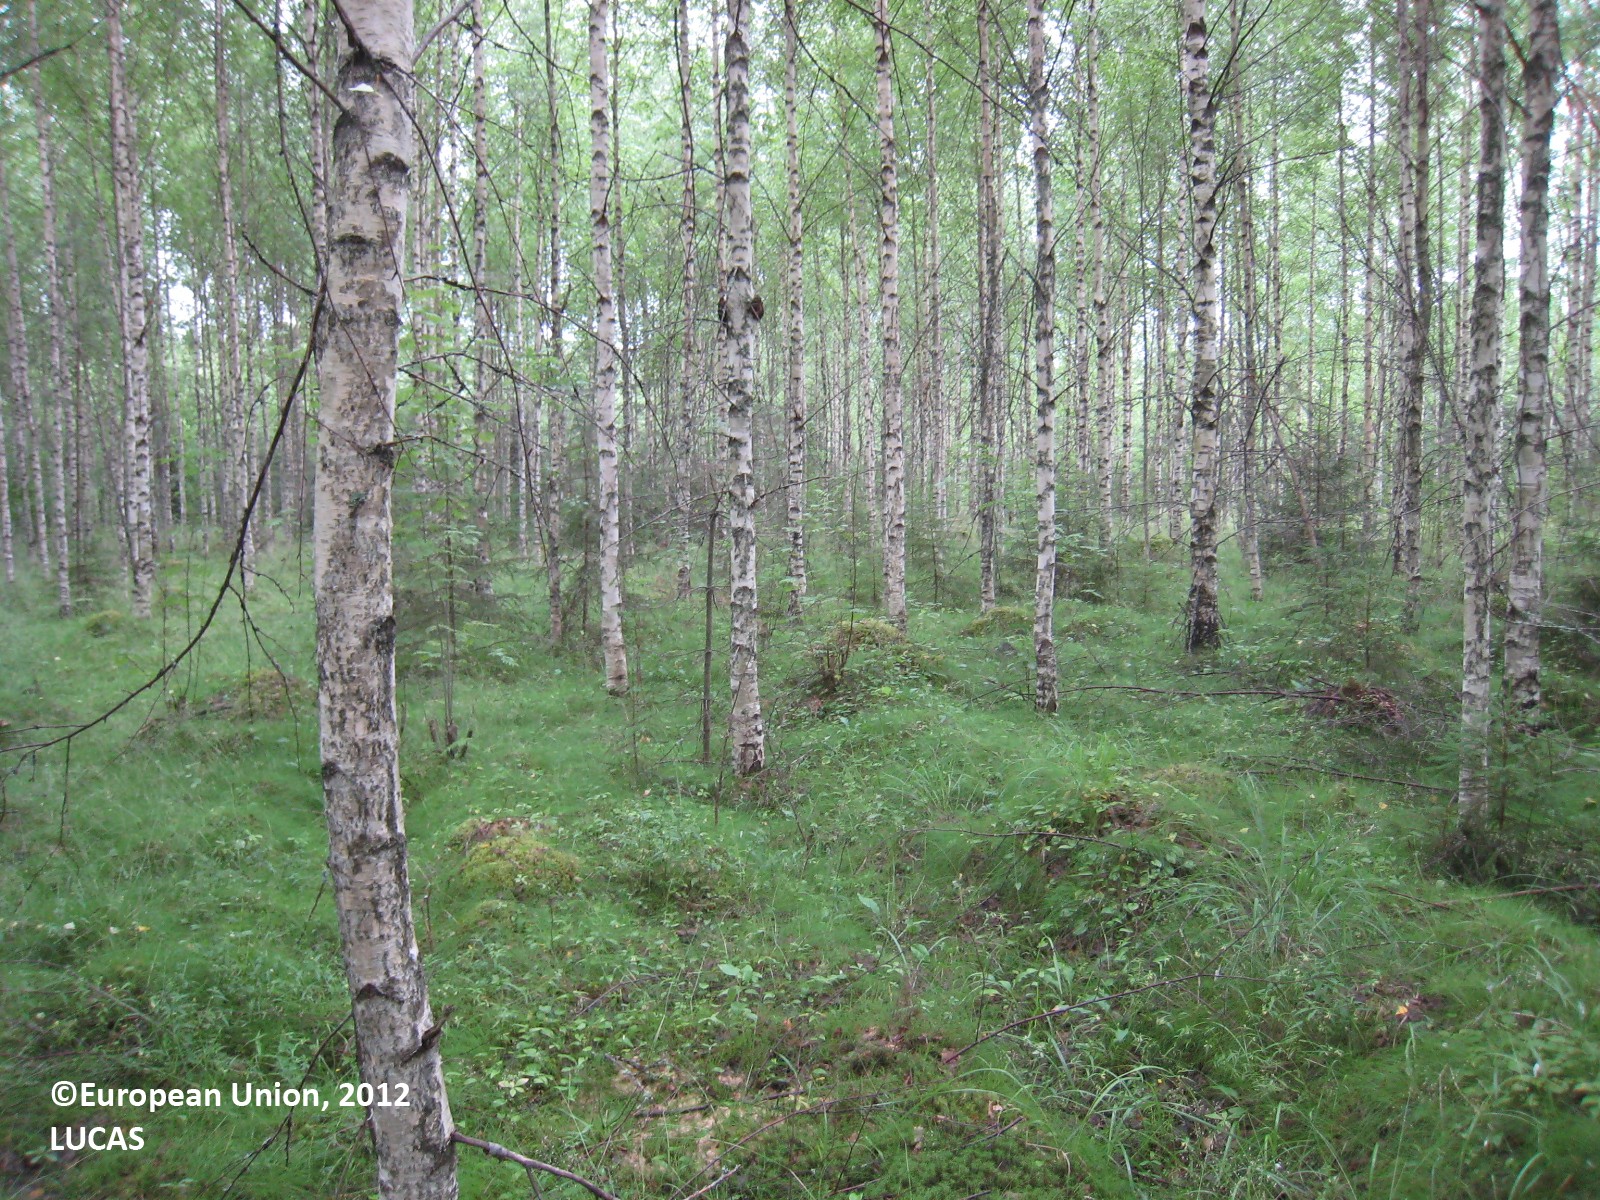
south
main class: Woodland
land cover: Broadleaved woodland
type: non-riverine alder, birch or aspen forest
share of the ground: > 75 %
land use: Forestry
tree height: > 5 m
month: July
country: FI
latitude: 61.7415
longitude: 27.3430
